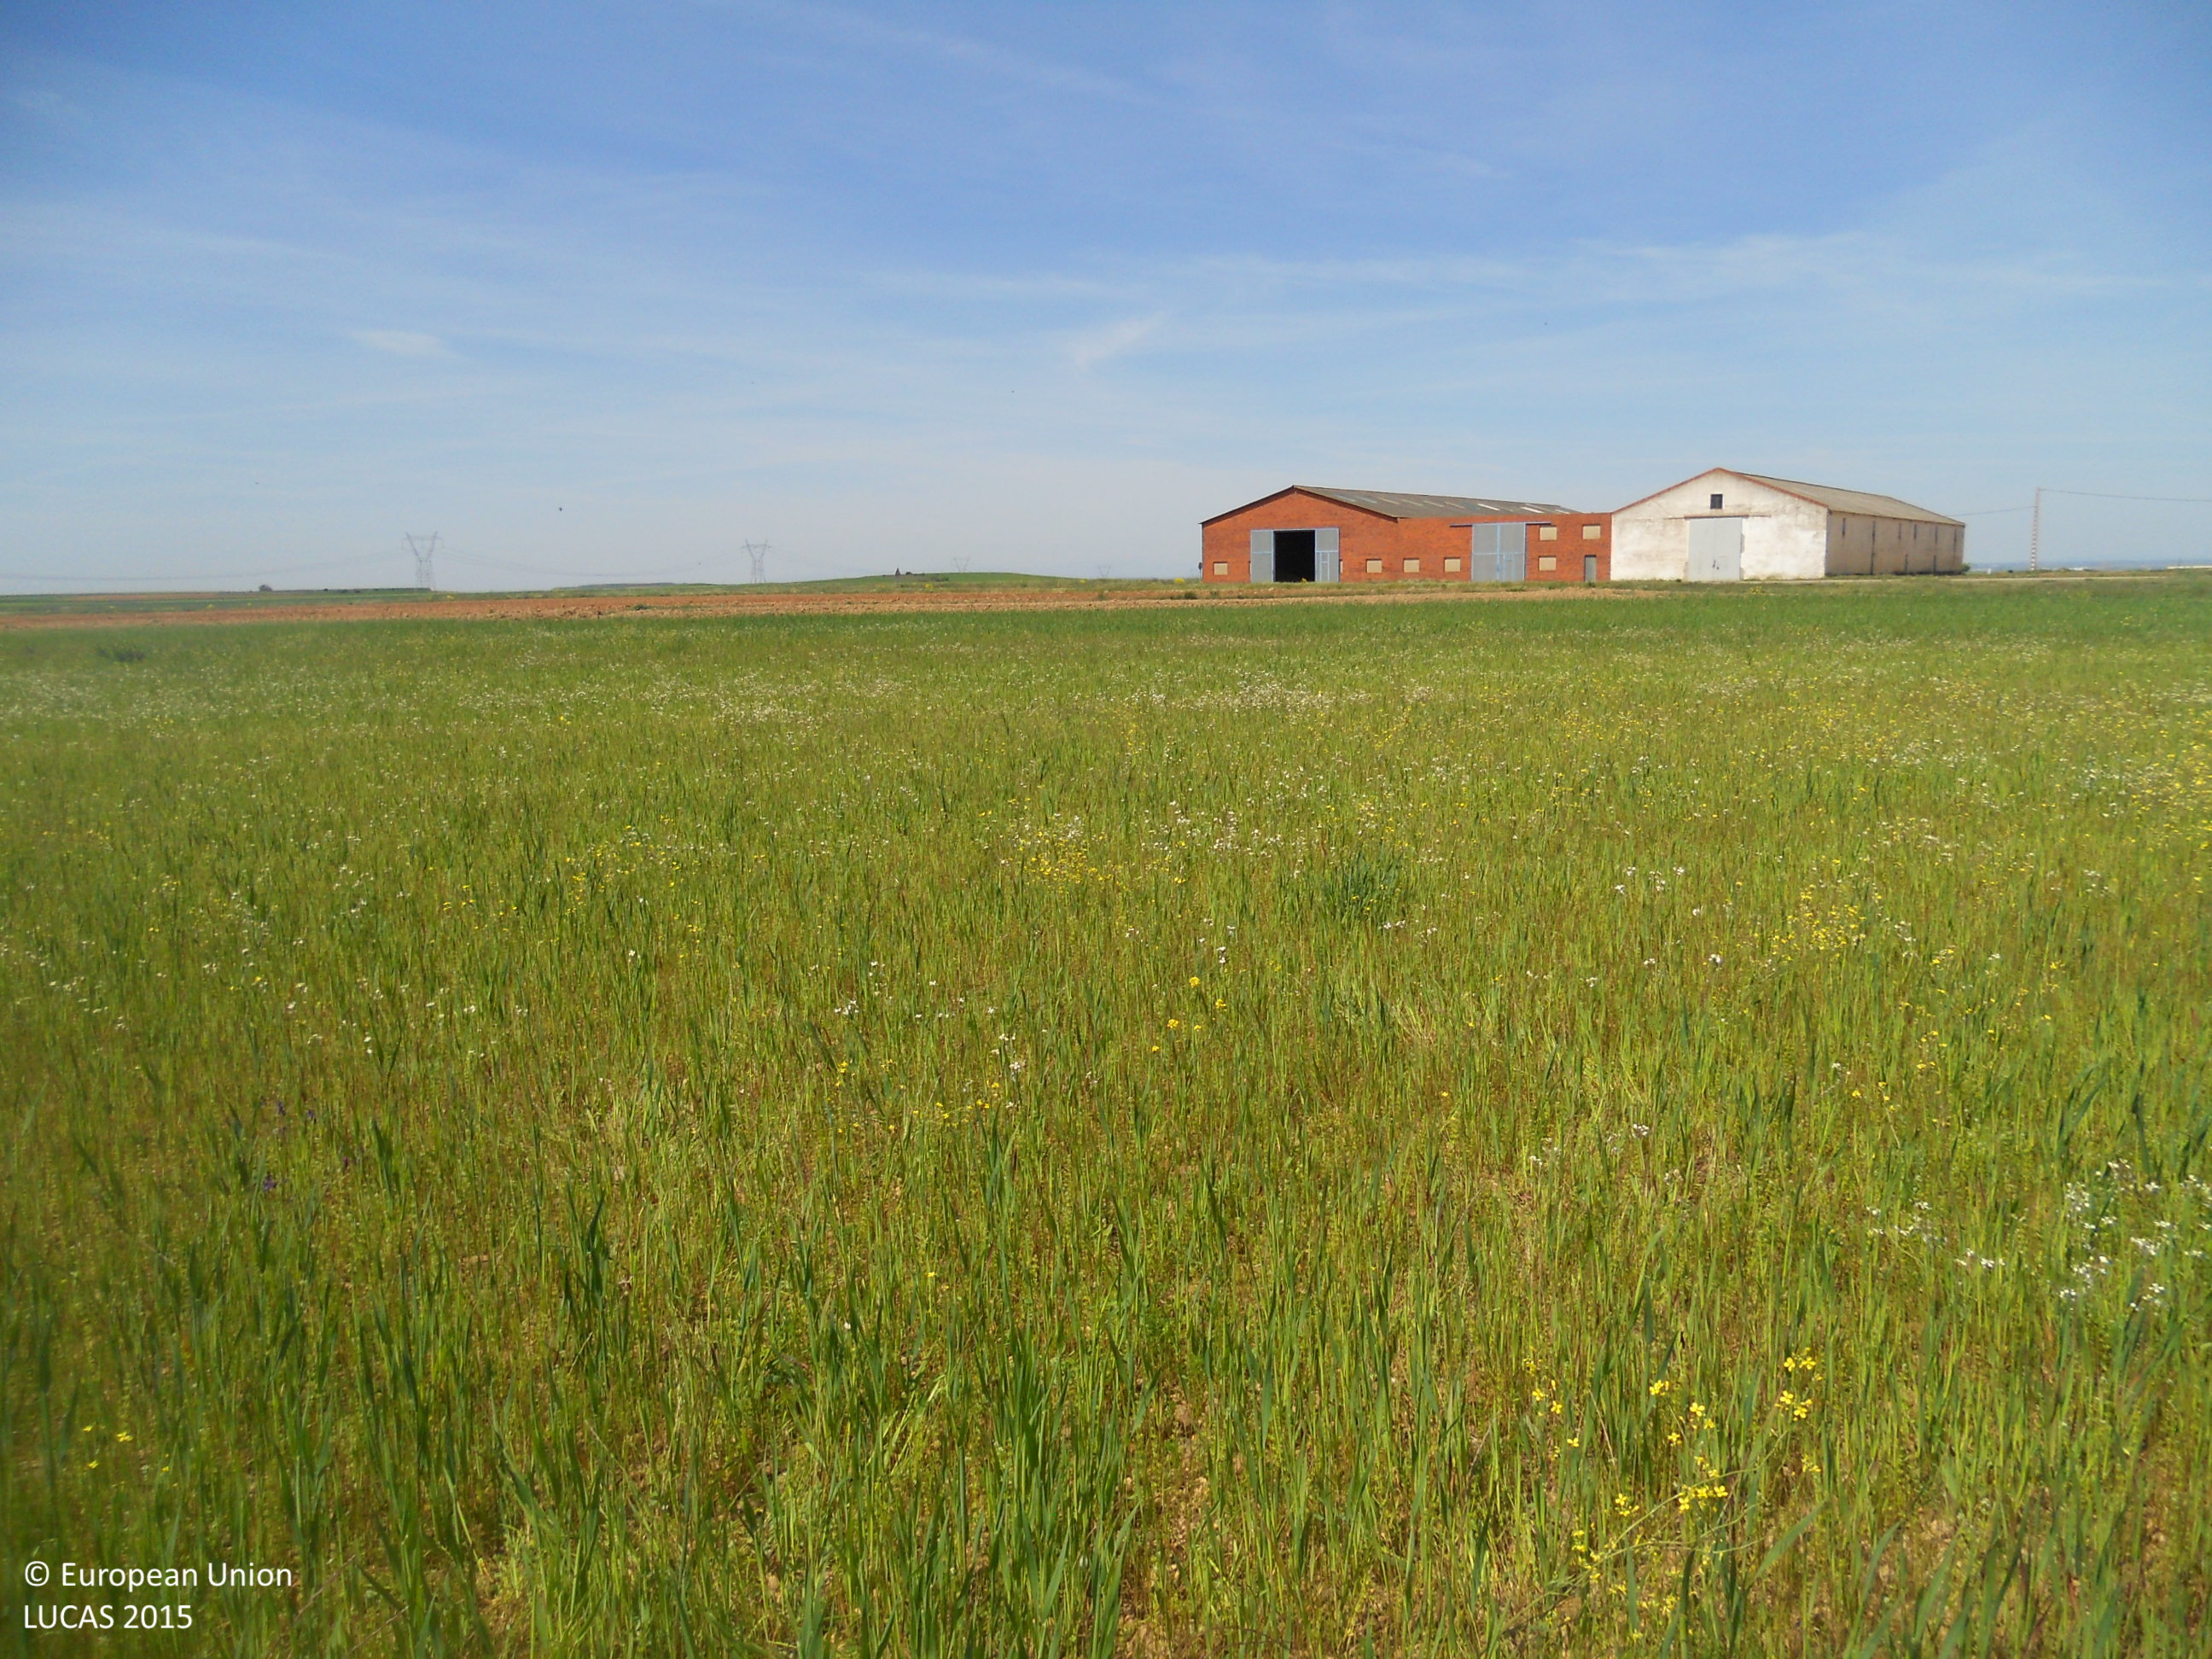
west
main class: Cropland
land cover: Oats
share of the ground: > 75 %
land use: Agriculture (excluding fallow land and kitchen gardens)
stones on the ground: 10 - 25 %
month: May
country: ES
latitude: 42.4271
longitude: -5.3690
